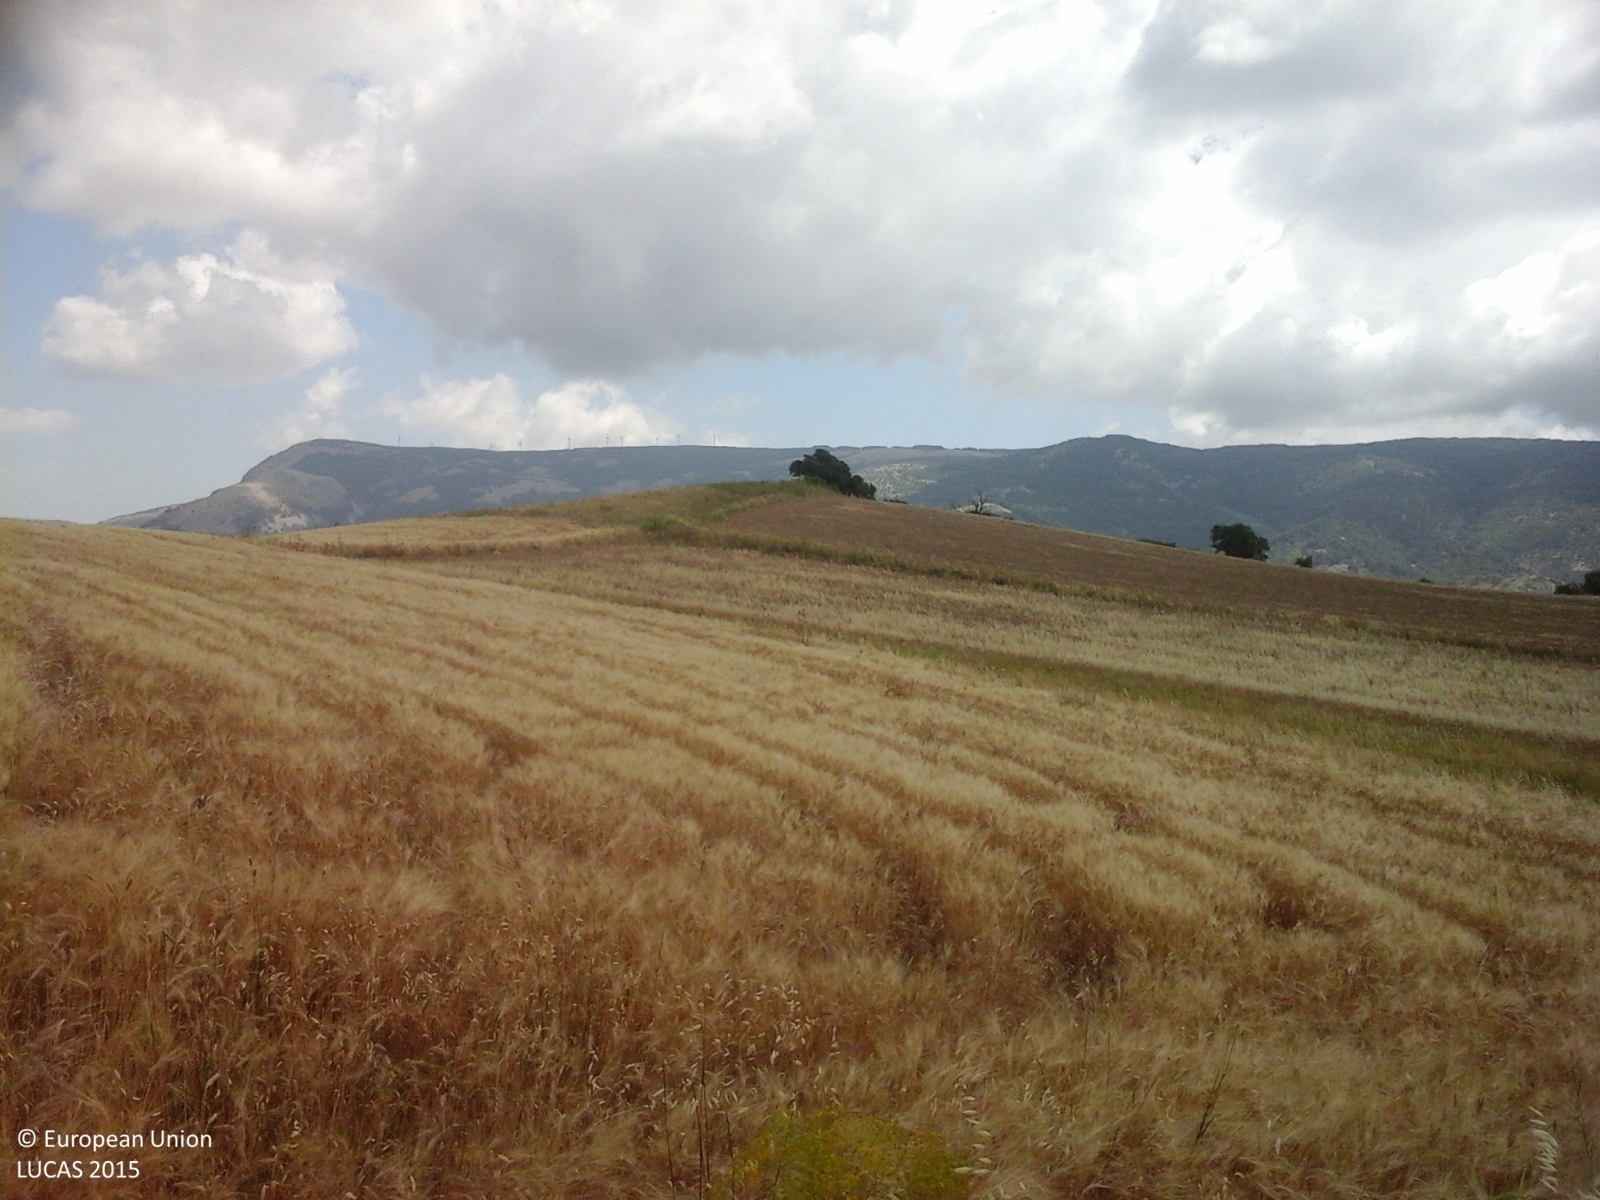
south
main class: Cropland
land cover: Durum wheat
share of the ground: > 75 %
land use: Agriculture (excluding fallow land and kitchen gardens)
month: June
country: IT
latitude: 37.6594
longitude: 13.1391
